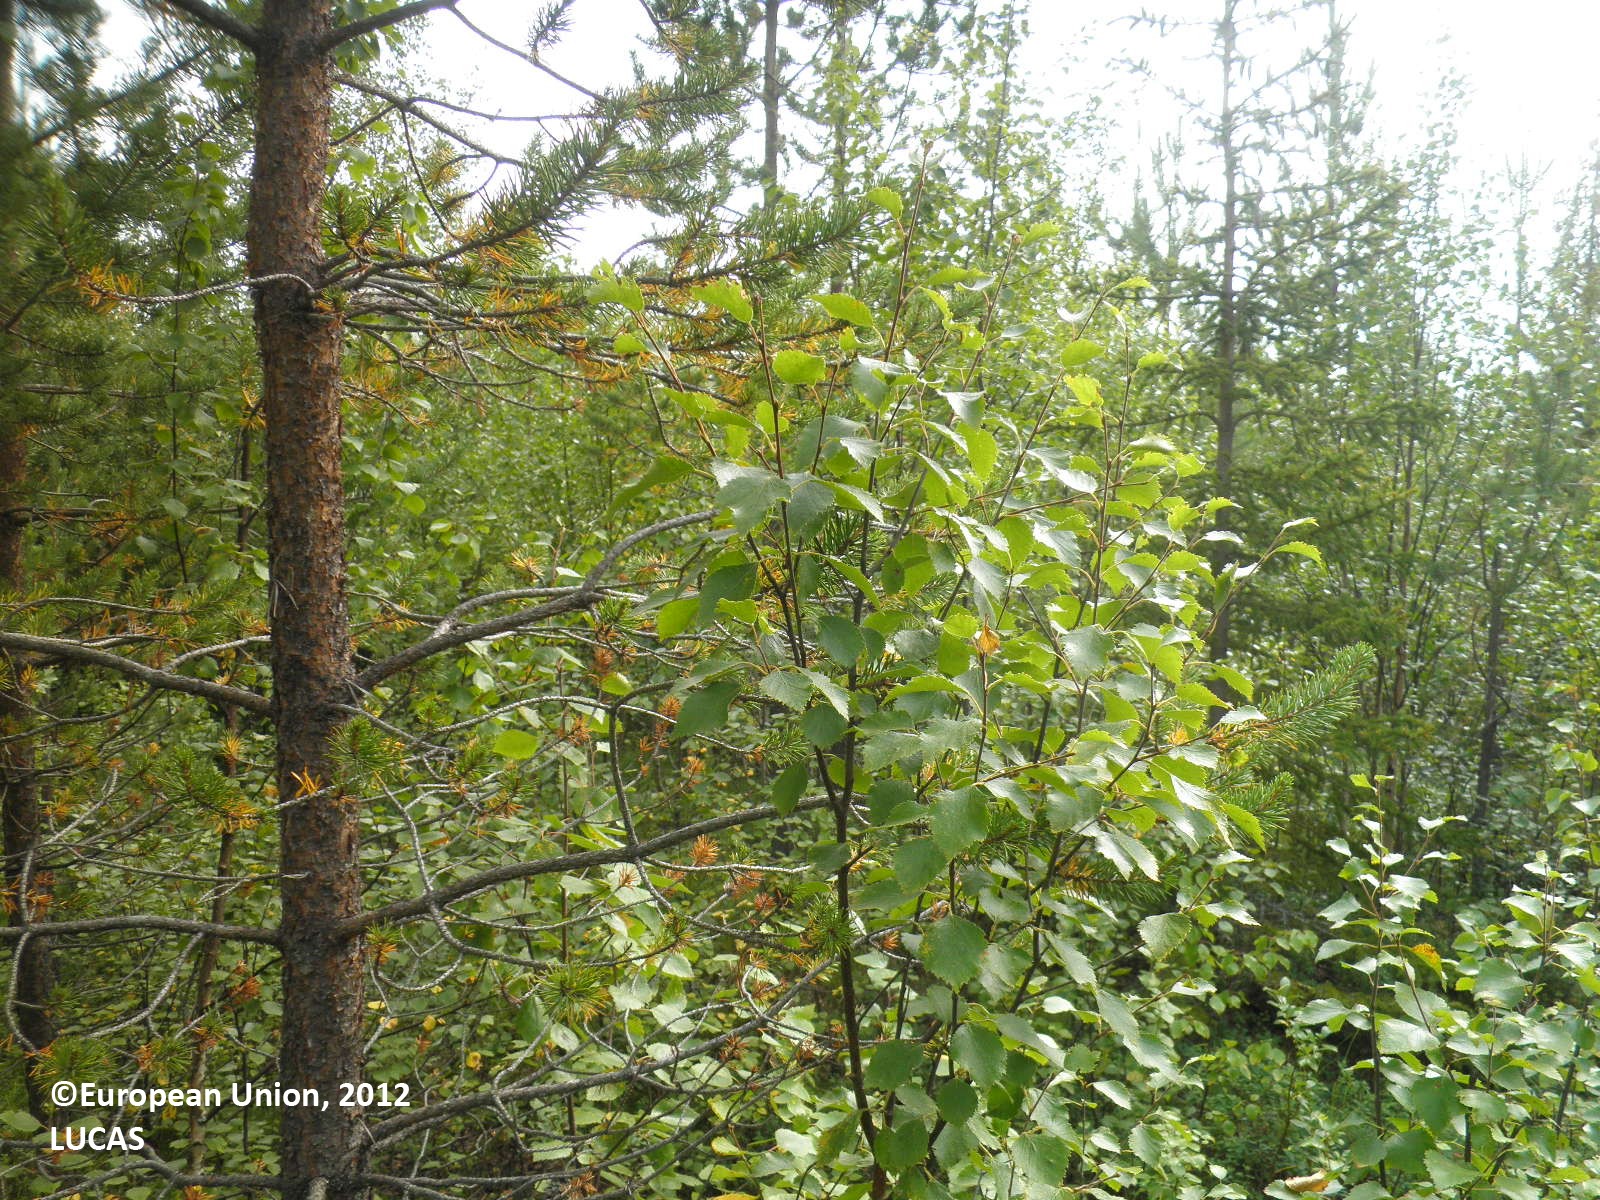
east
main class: Woodland
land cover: Pine dominated mixed woodland
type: boreal forest
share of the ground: 50 - 75 %
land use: Forestry
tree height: > 5 m
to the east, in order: Pine dominated mixed woodland; Ditches and canals; Pine dominated mixed woodland; Ditches and canals; Pine dominated mixed woodland; Ditches and canals; Pine dominated mixed woodland; Ditches and canals; Pine dominated mixed woodland; Ditches and canals; Pine dominated mixed woodland; Ditches and canals; Pine dominated mixed woodland; Ditches and canals; Pine dominated mixed woodland; Ditches and canals; Pine dominated mixed woodland; Ditches and canals; Pine dominated mixed woodland; Ditches and canals; Pine dominated mixed woodland
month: August
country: FI
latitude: 67.5387
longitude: 27.0903
